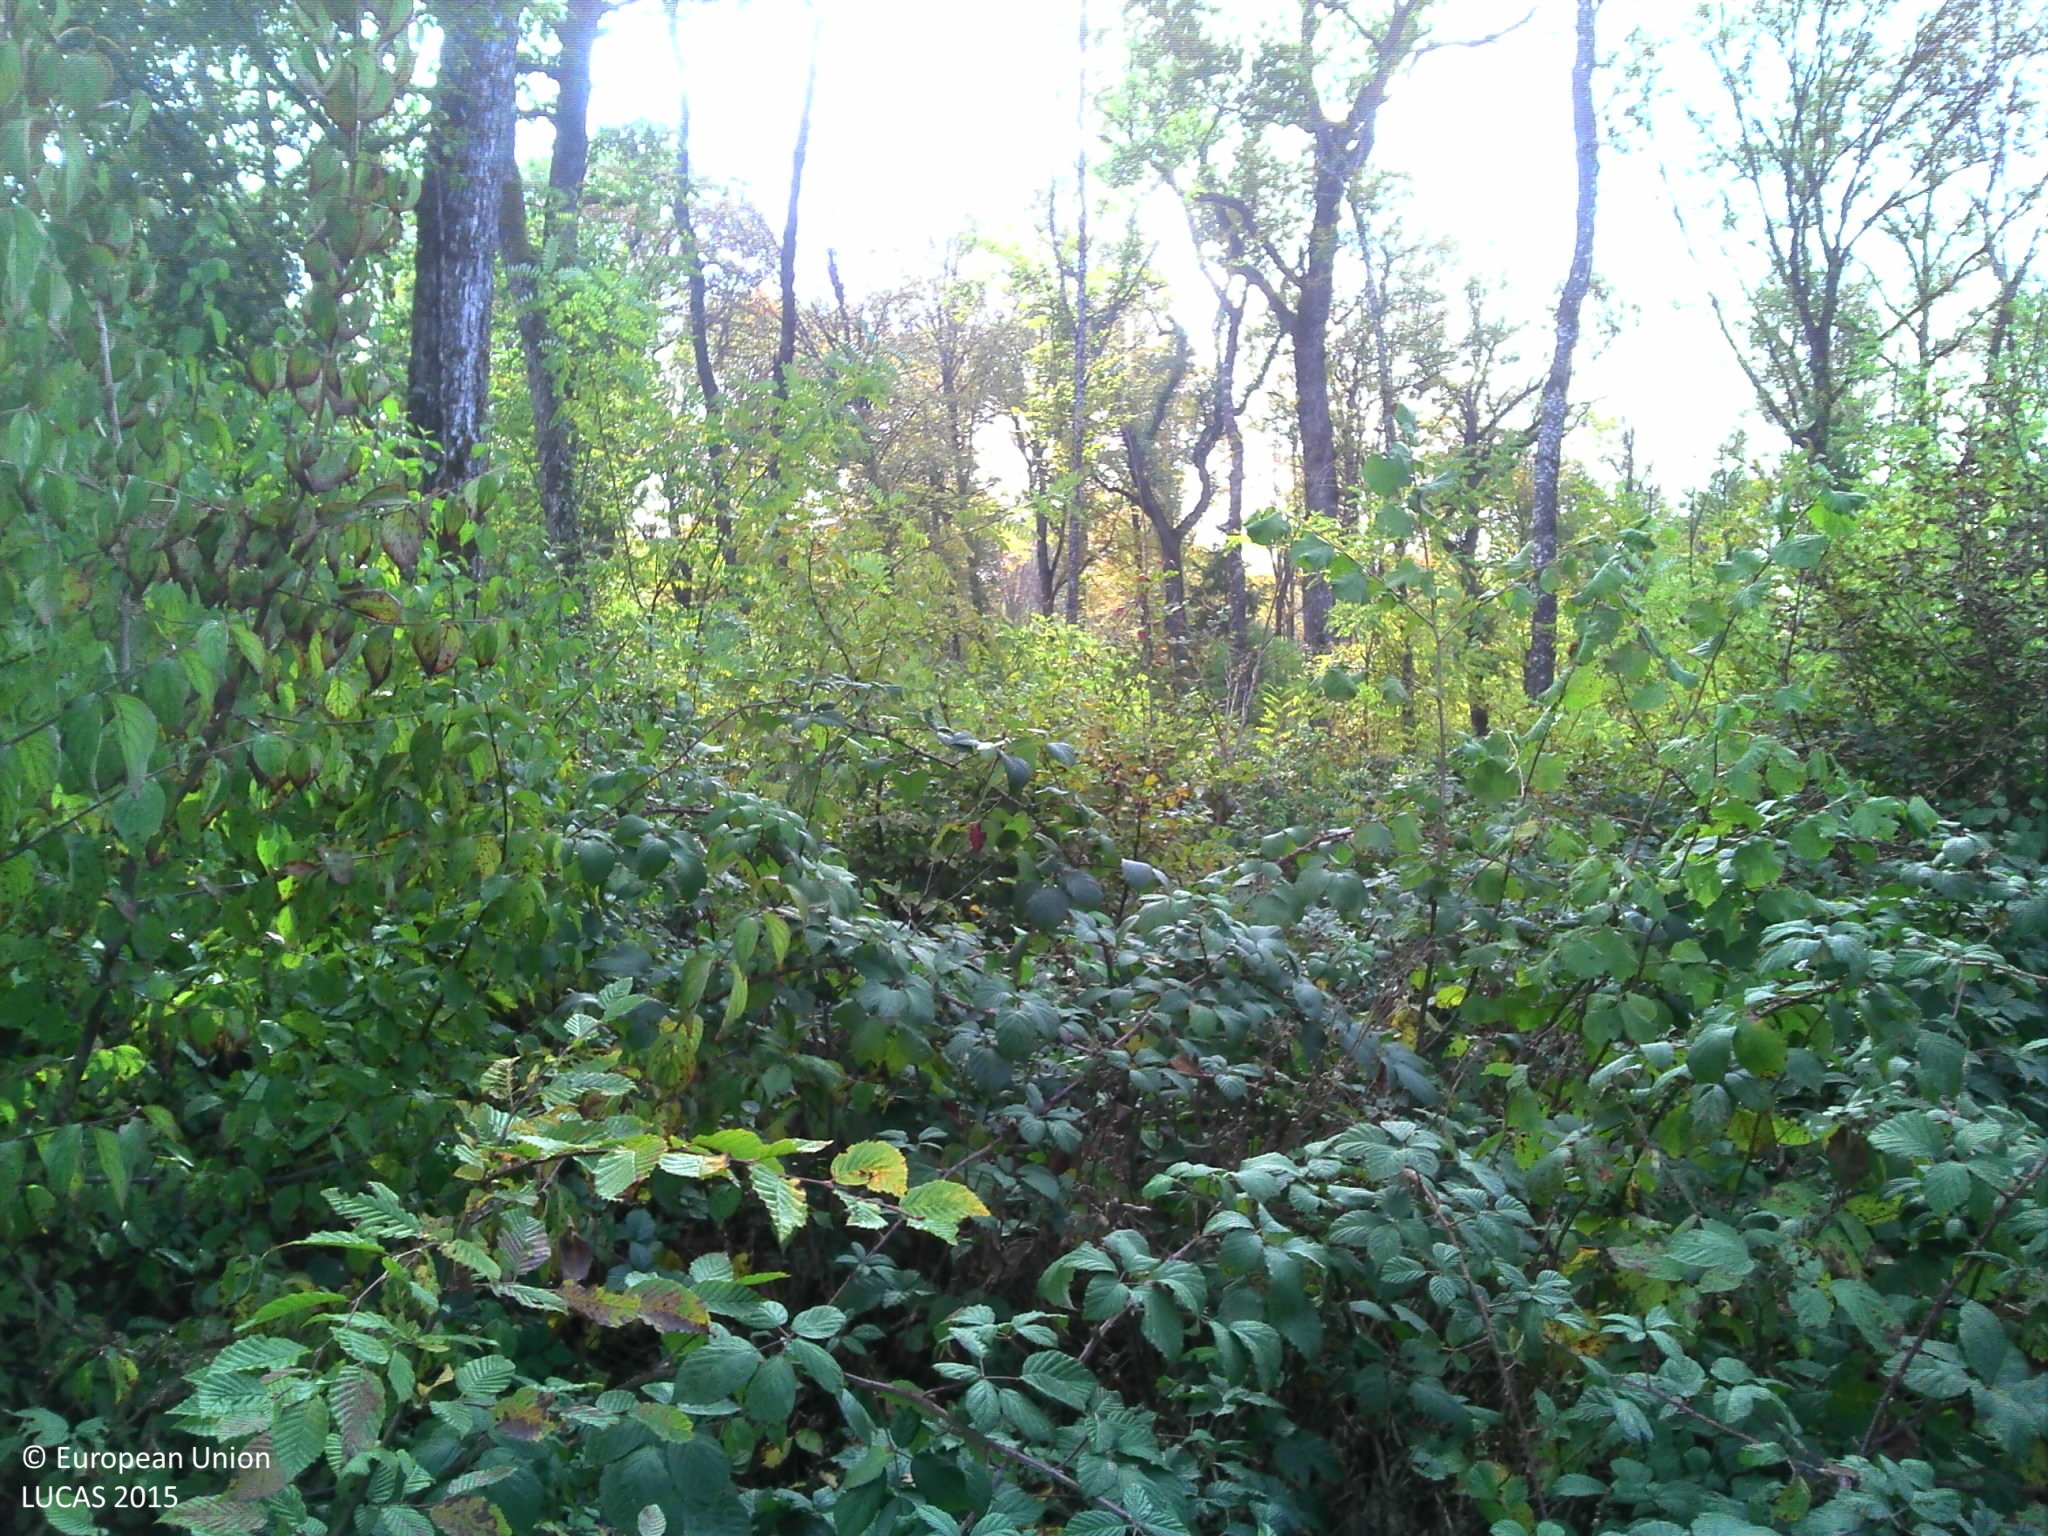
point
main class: Woodland
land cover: Broadleaved woodland
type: mesophytic deciduous forest
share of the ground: > 75 %
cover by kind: broadleaved forest trees 100 %
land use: Forestry
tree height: > 5 m
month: October
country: FR
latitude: 47.5626
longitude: 5.2555
